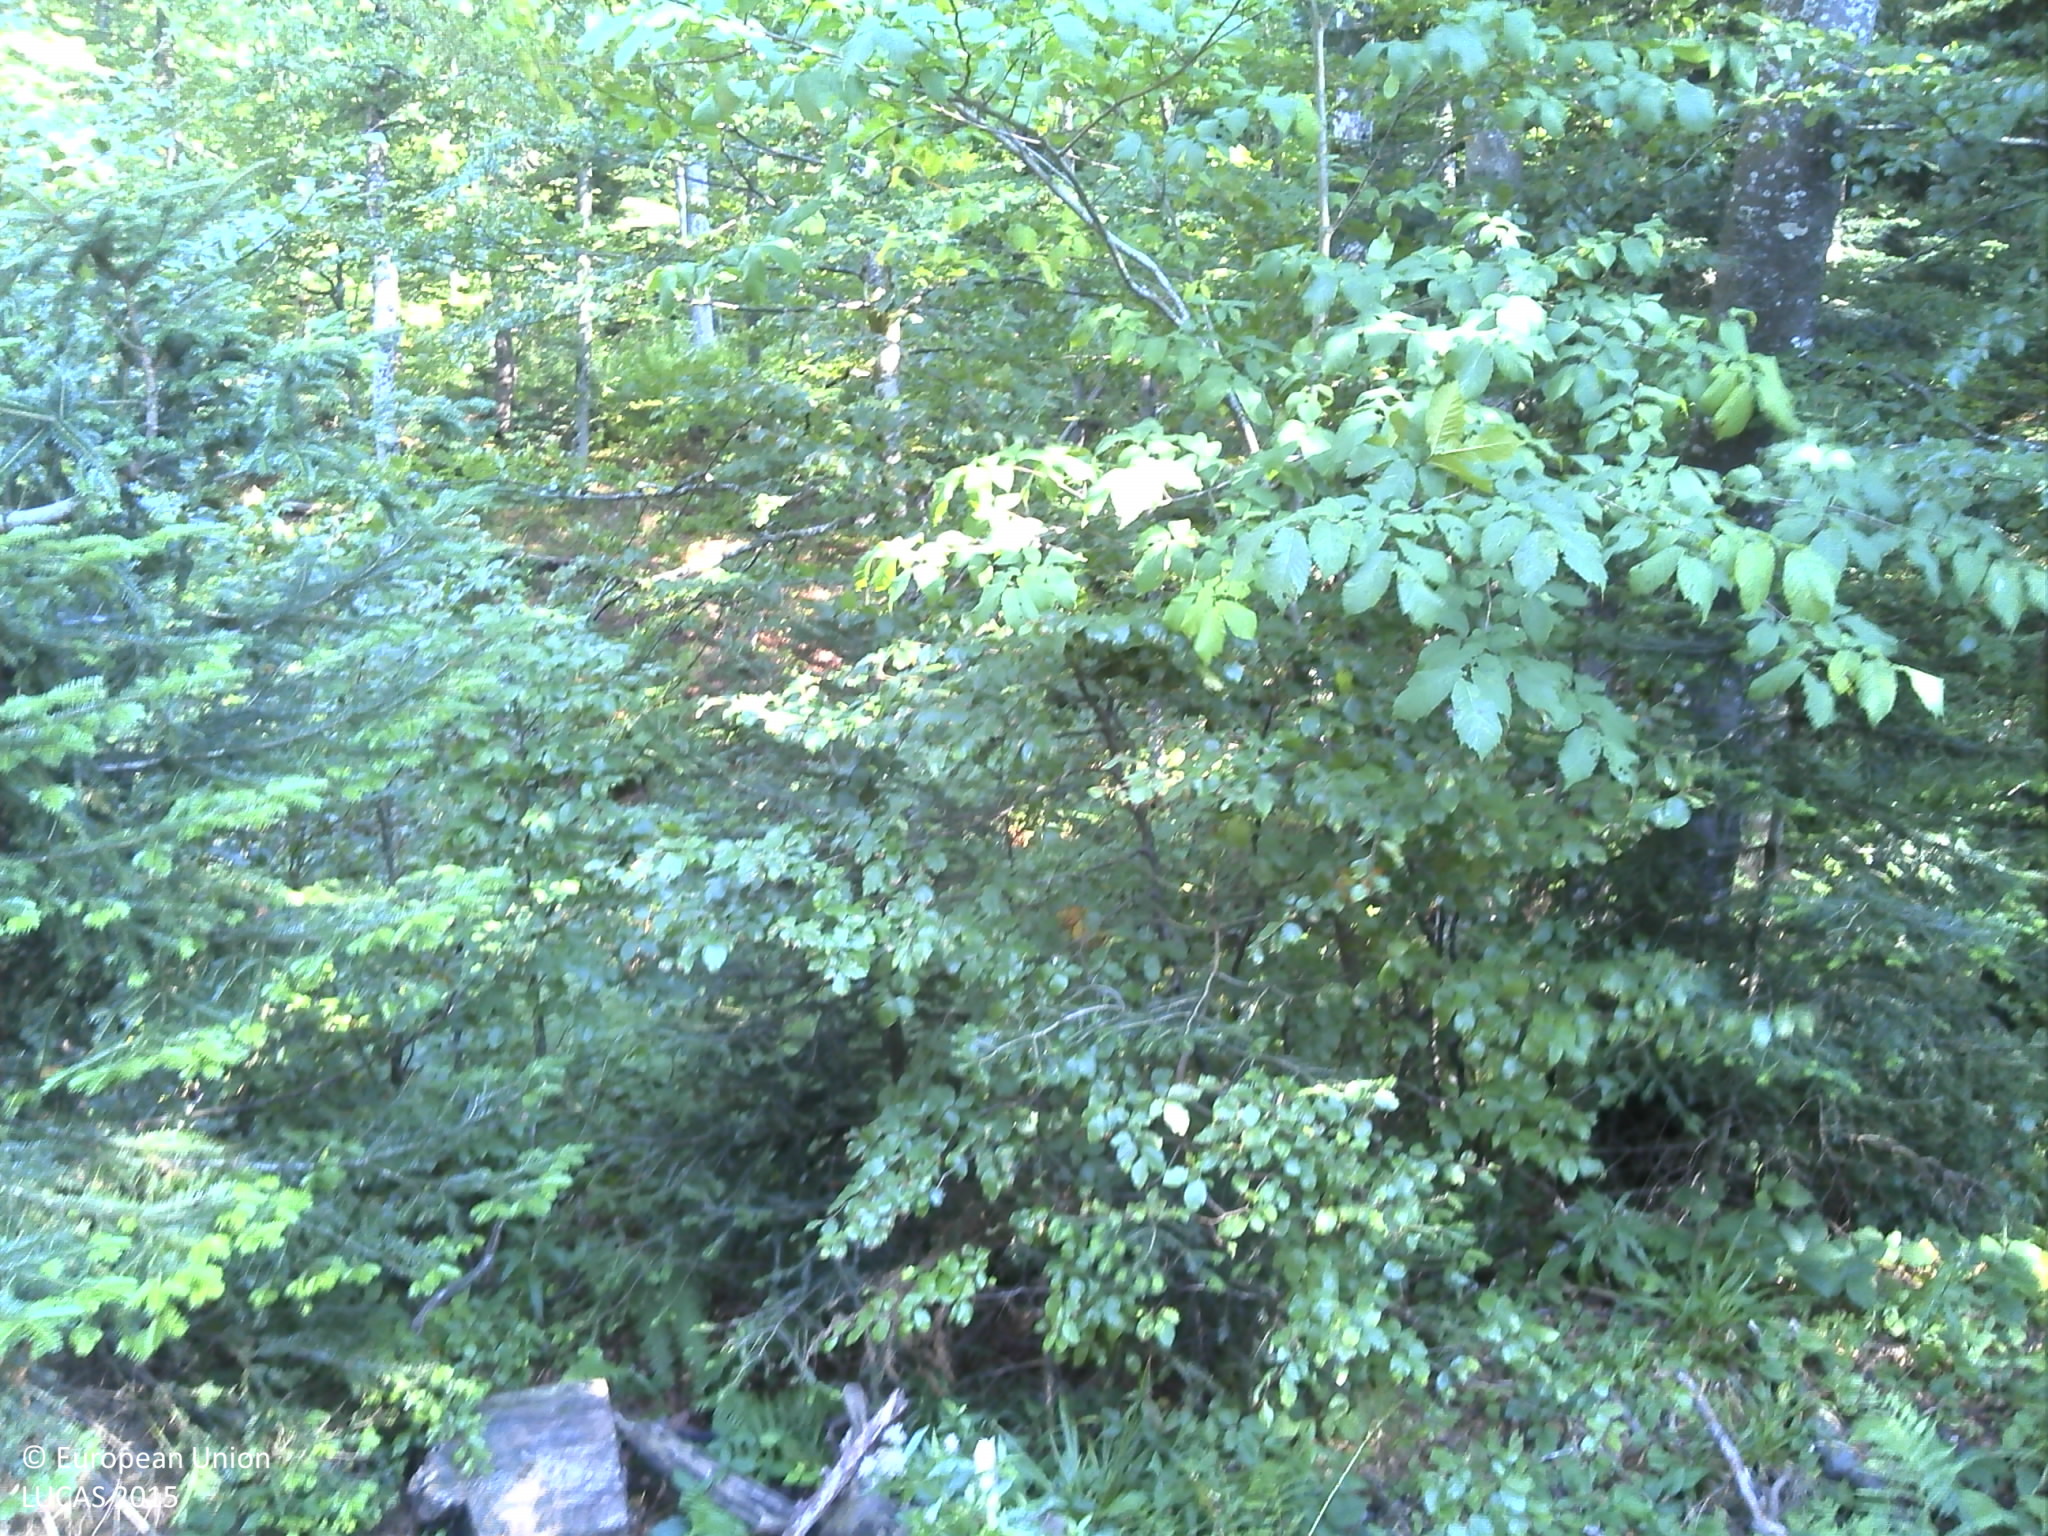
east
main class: Woodland
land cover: Broadleaved woodland
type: beech forest
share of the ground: > 75 %
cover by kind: broadleaved forest trees 100 %
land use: Forestry
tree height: > 5 m
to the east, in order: Broadleaved woodland; Paved roads, cycling and walking lanes; Broadleaved woodland
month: September
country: HR
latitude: 45.2930
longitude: 15.0573
